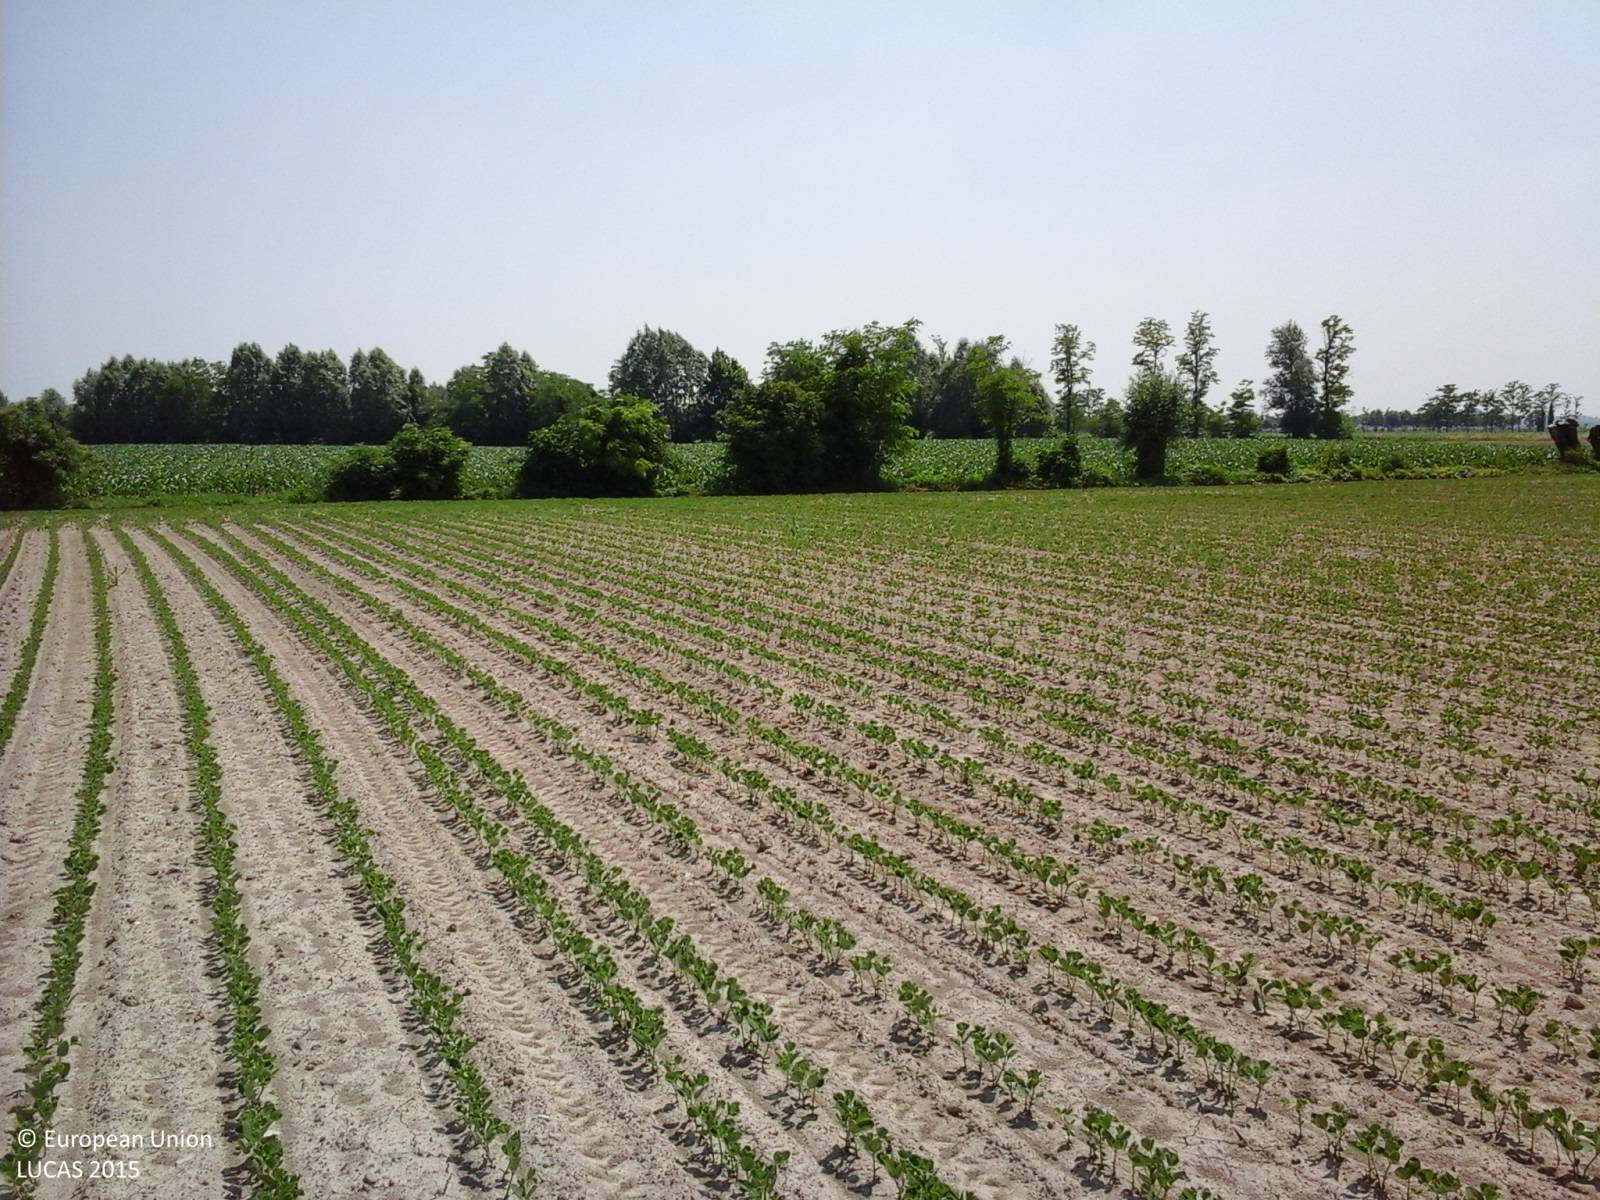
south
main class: Cropland
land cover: Soya
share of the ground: < 10 %
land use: Agriculture (excluding fallow land and kitchen gardens)
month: June
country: IT
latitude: 45.8420
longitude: 12.9448
